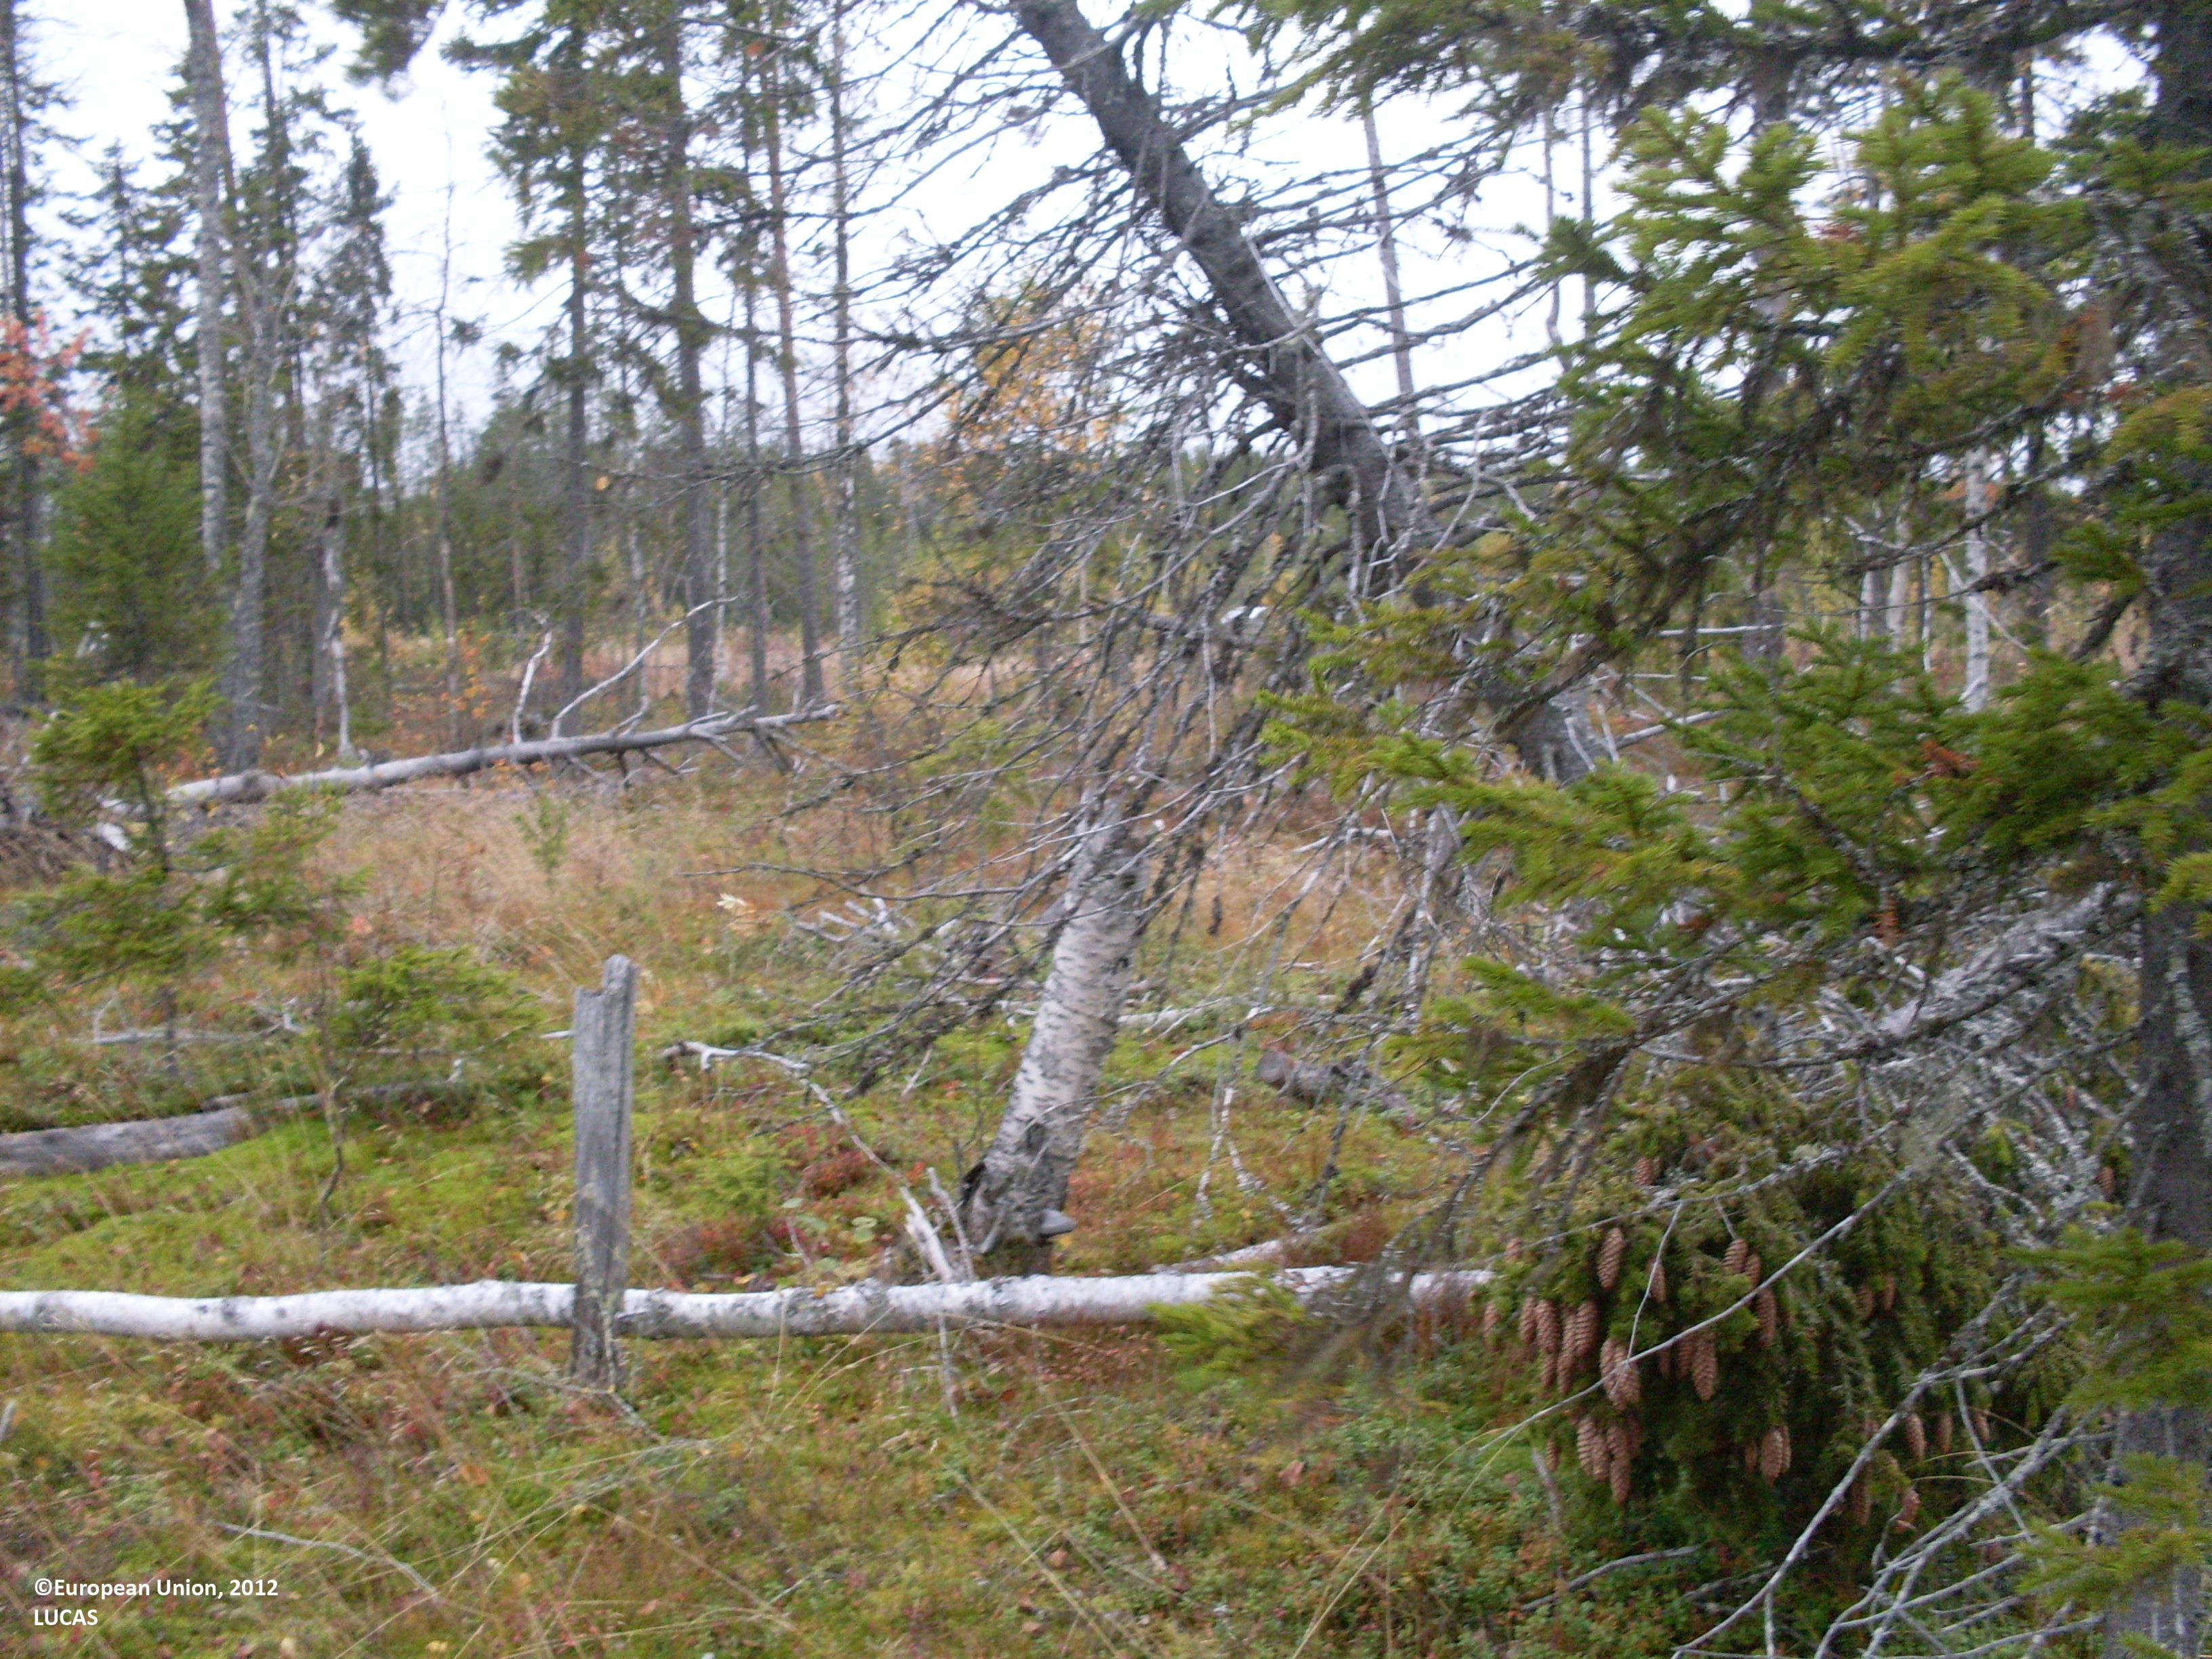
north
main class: Shrubland
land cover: Shrubland with sparse tree cover
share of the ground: 50 - 75 %
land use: Forestry
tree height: > 5 m
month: September
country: FI
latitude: 64.4147
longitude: 30.0141
